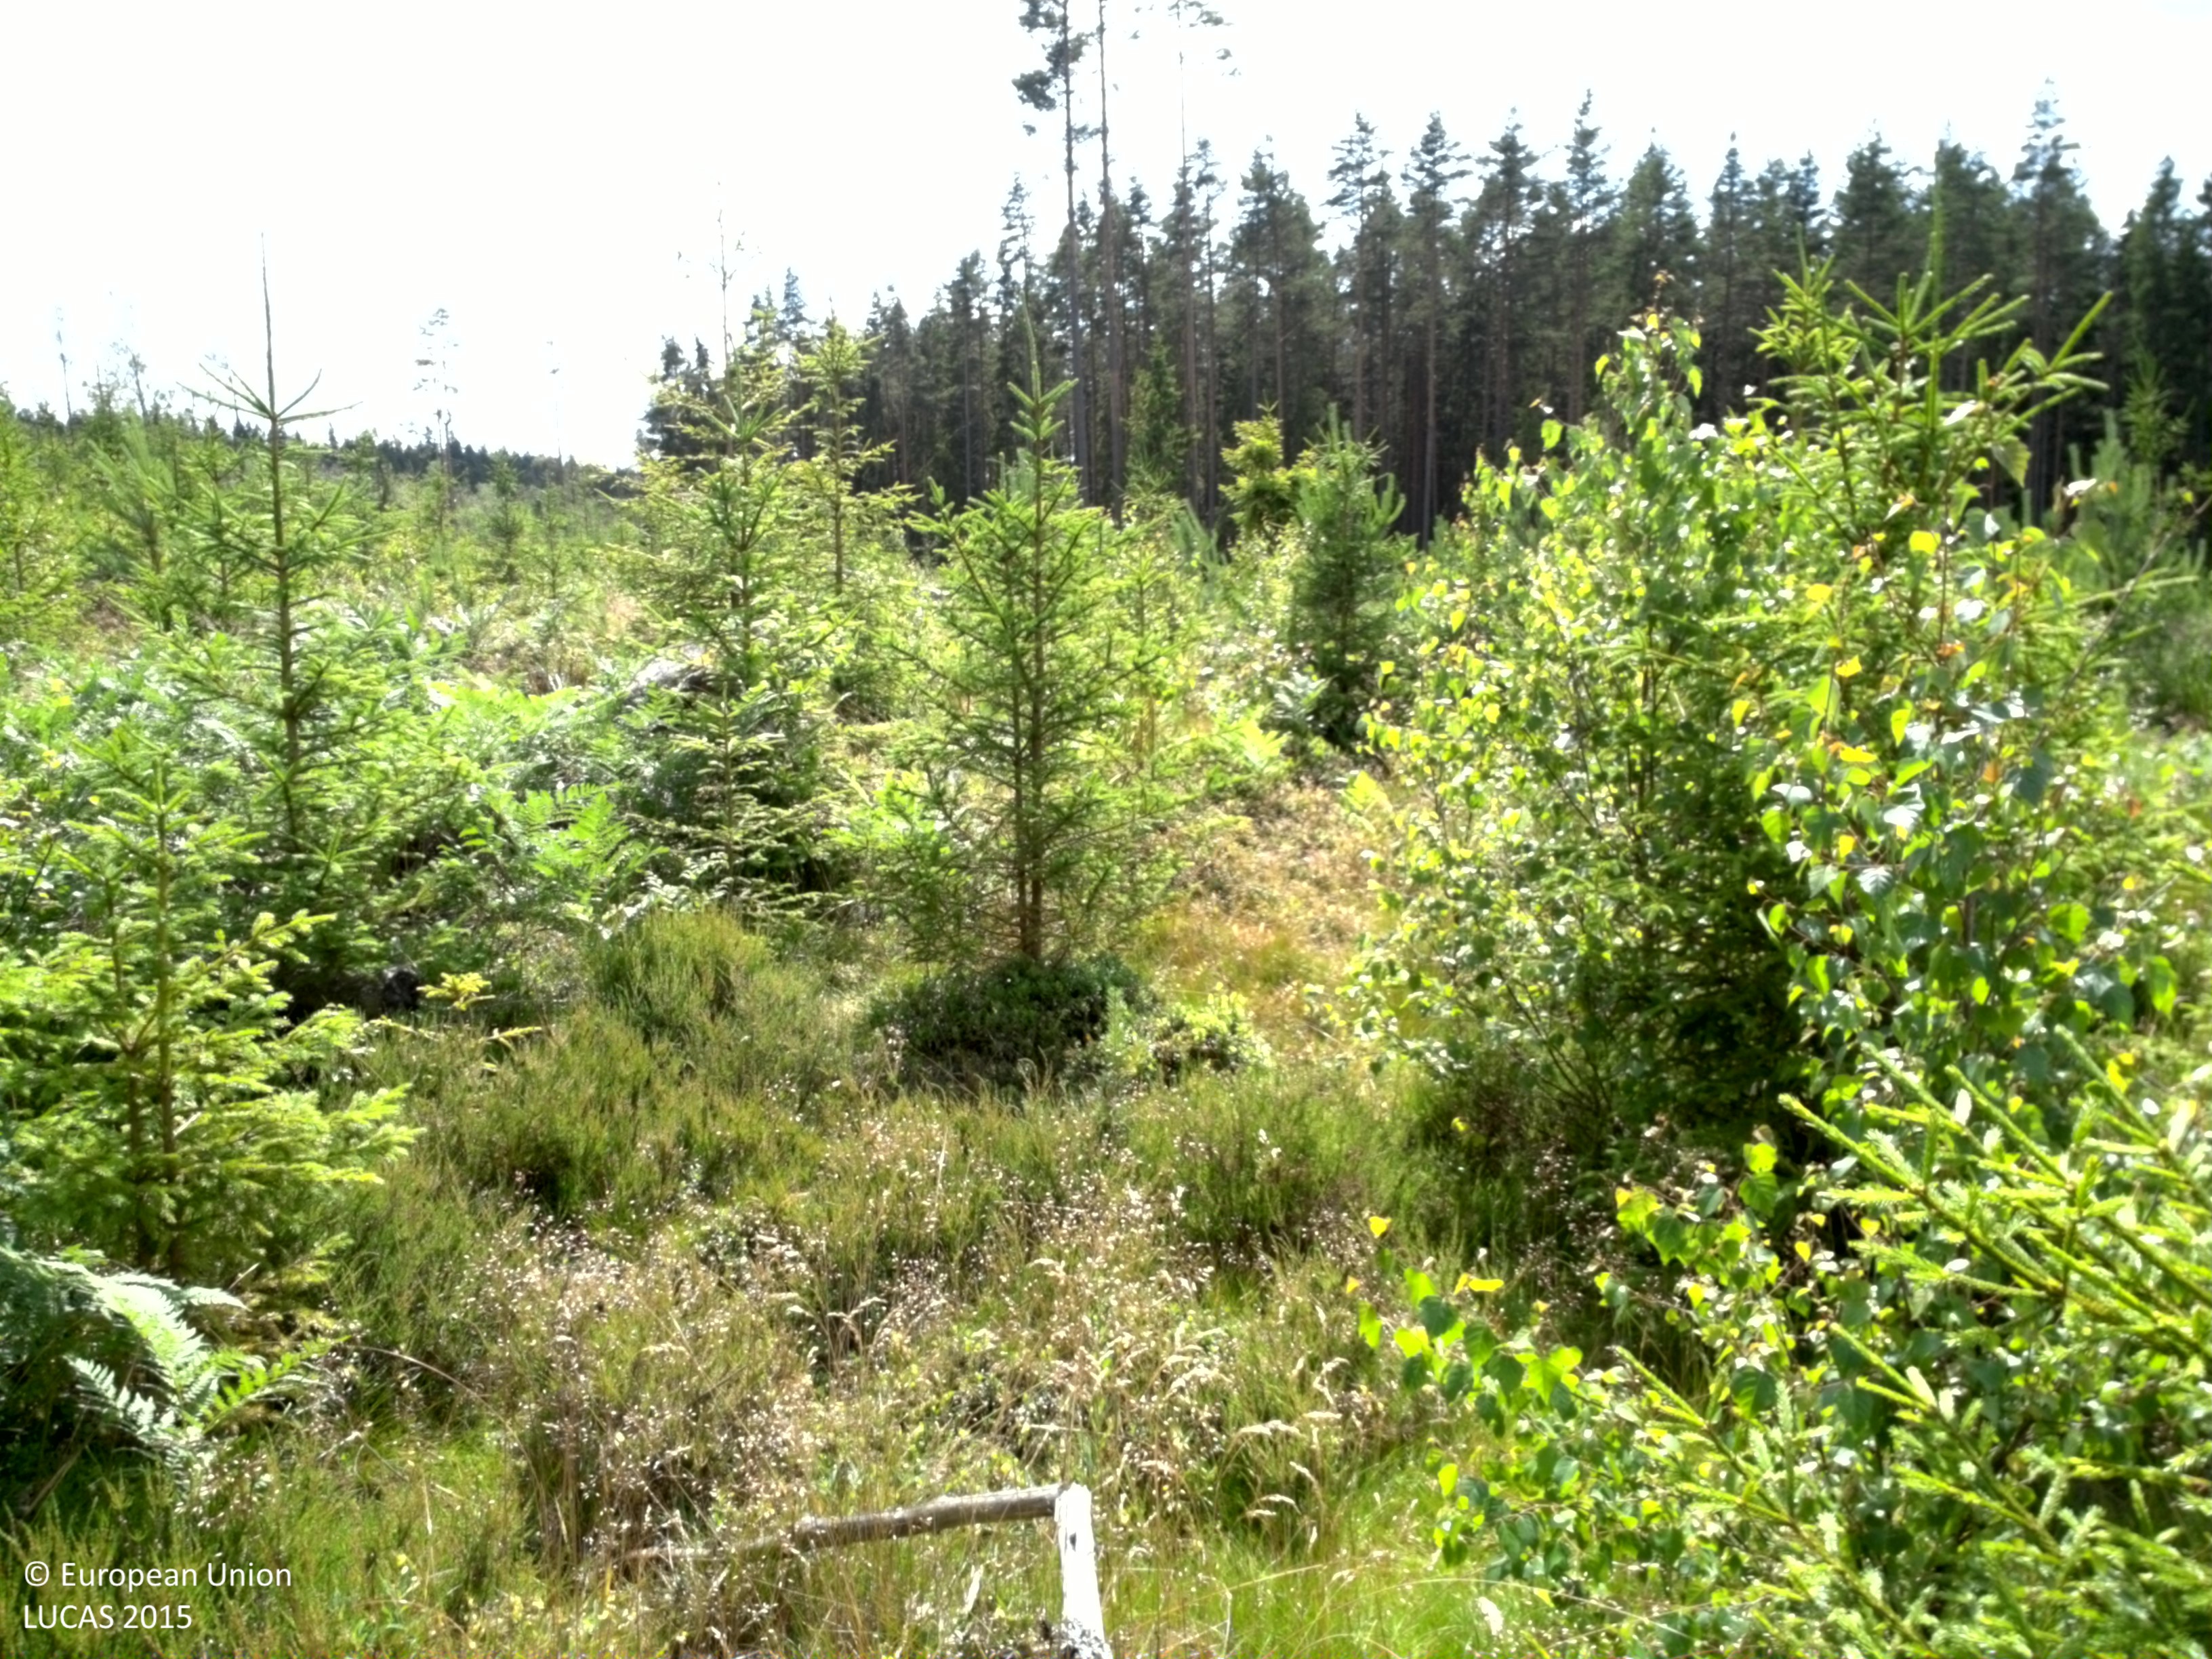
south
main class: Woodland
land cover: Other mixed woodland
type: boreal forest
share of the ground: 50 - 75 %
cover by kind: coniferous forest trees 40 %, broadleaved forest trees 20 %, herbaceous plants 20 %, shrubs 10 %, lichens and mosses 10 %
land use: Forestry
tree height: < 5 m
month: July
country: SE
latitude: 58.8633
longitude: 14.5527
